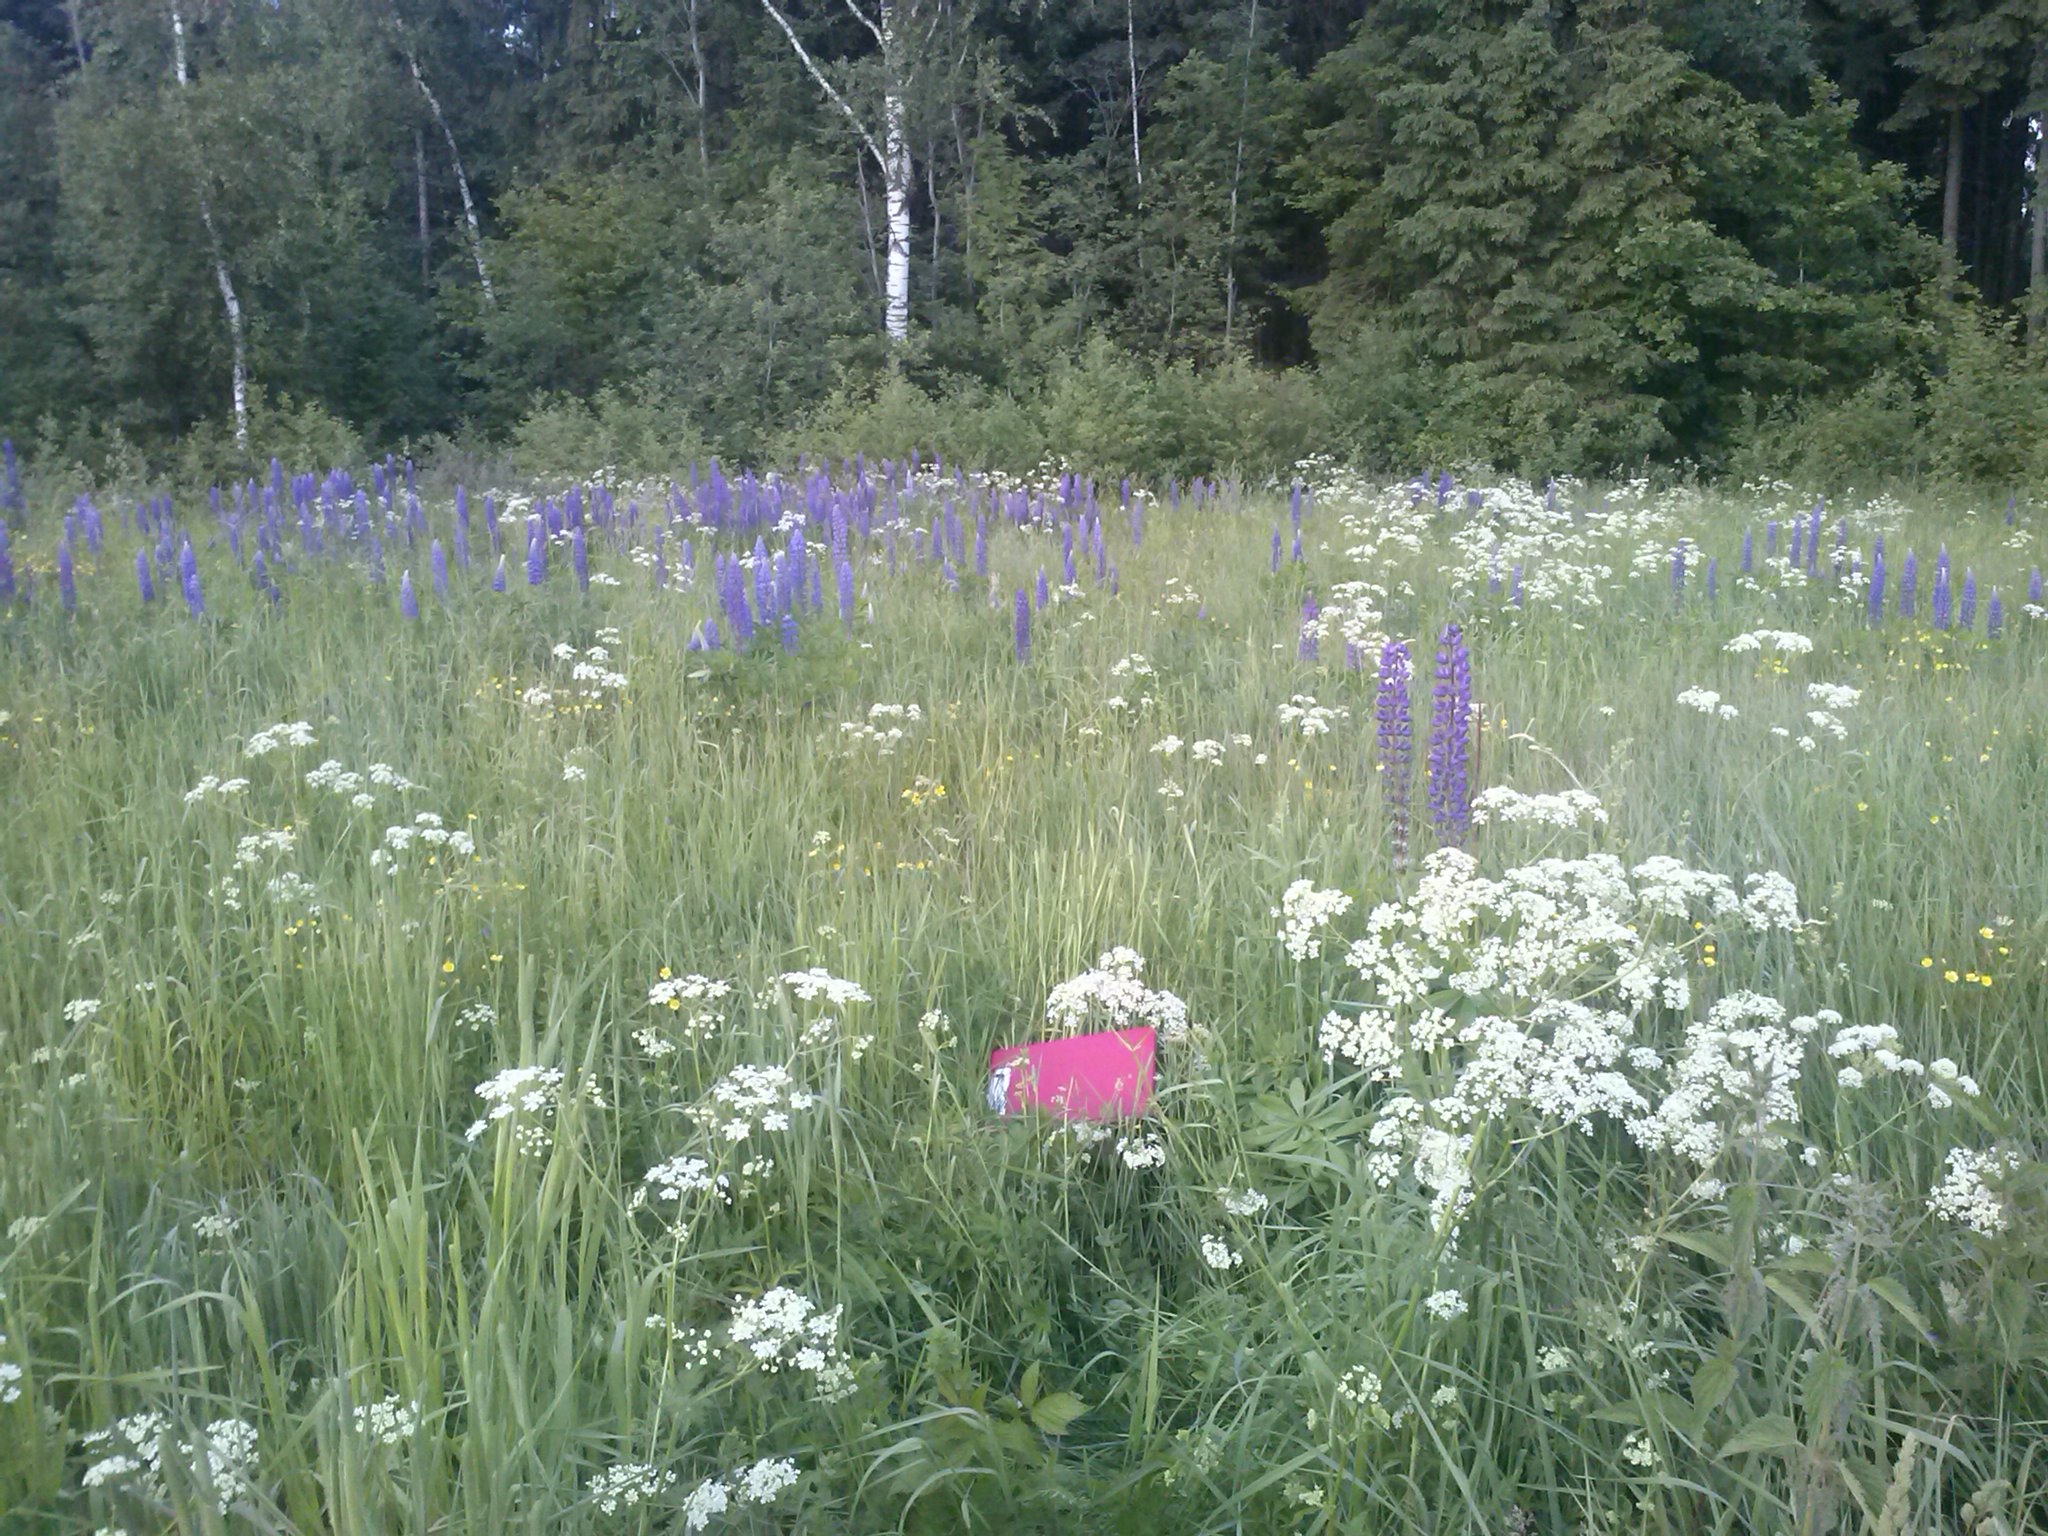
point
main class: Grassland
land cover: Grassland without tree/shrub cover
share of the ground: > 75 %
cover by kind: herbaceous plants 100 %
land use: Agriculture (excluding fallow land and kitchen gardens)
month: June
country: LV
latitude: 56.5267
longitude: 27.4587
